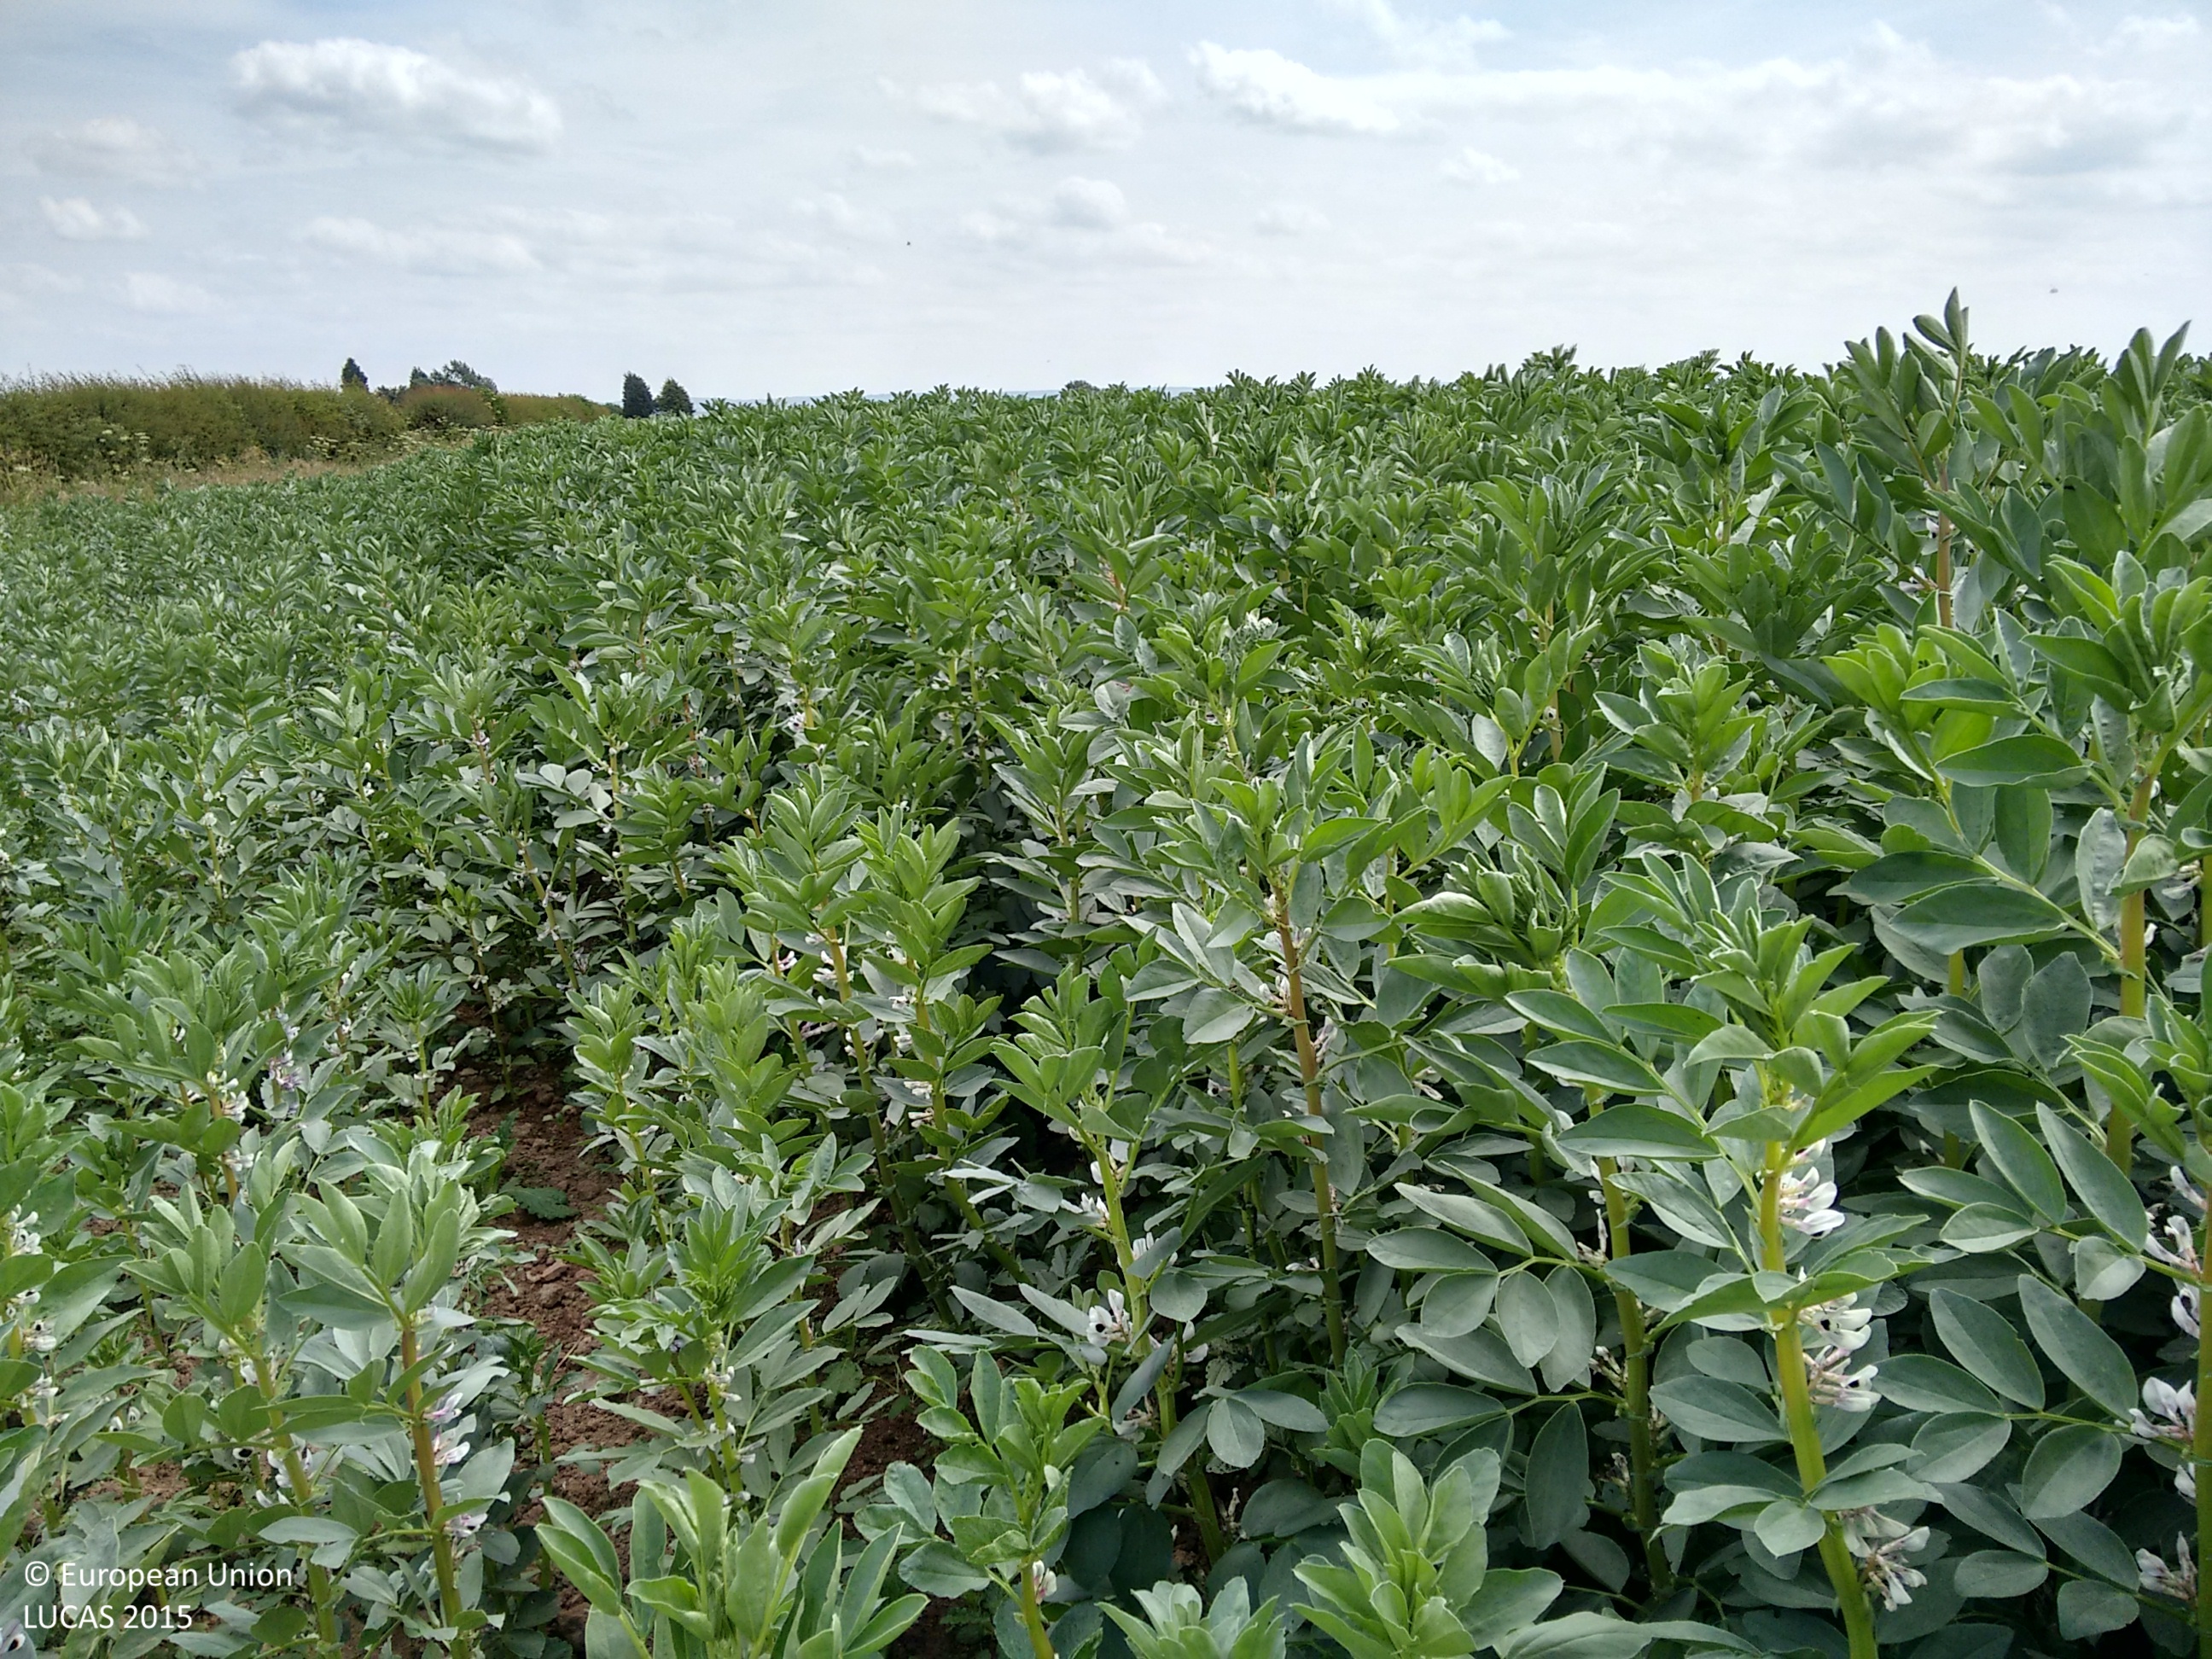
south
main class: Cropland
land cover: Dry pulses
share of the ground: > 75 %
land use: Agriculture (excluding fallow land and kitchen gardens)
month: June
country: GB
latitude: 52.9959
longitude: -0.9343
